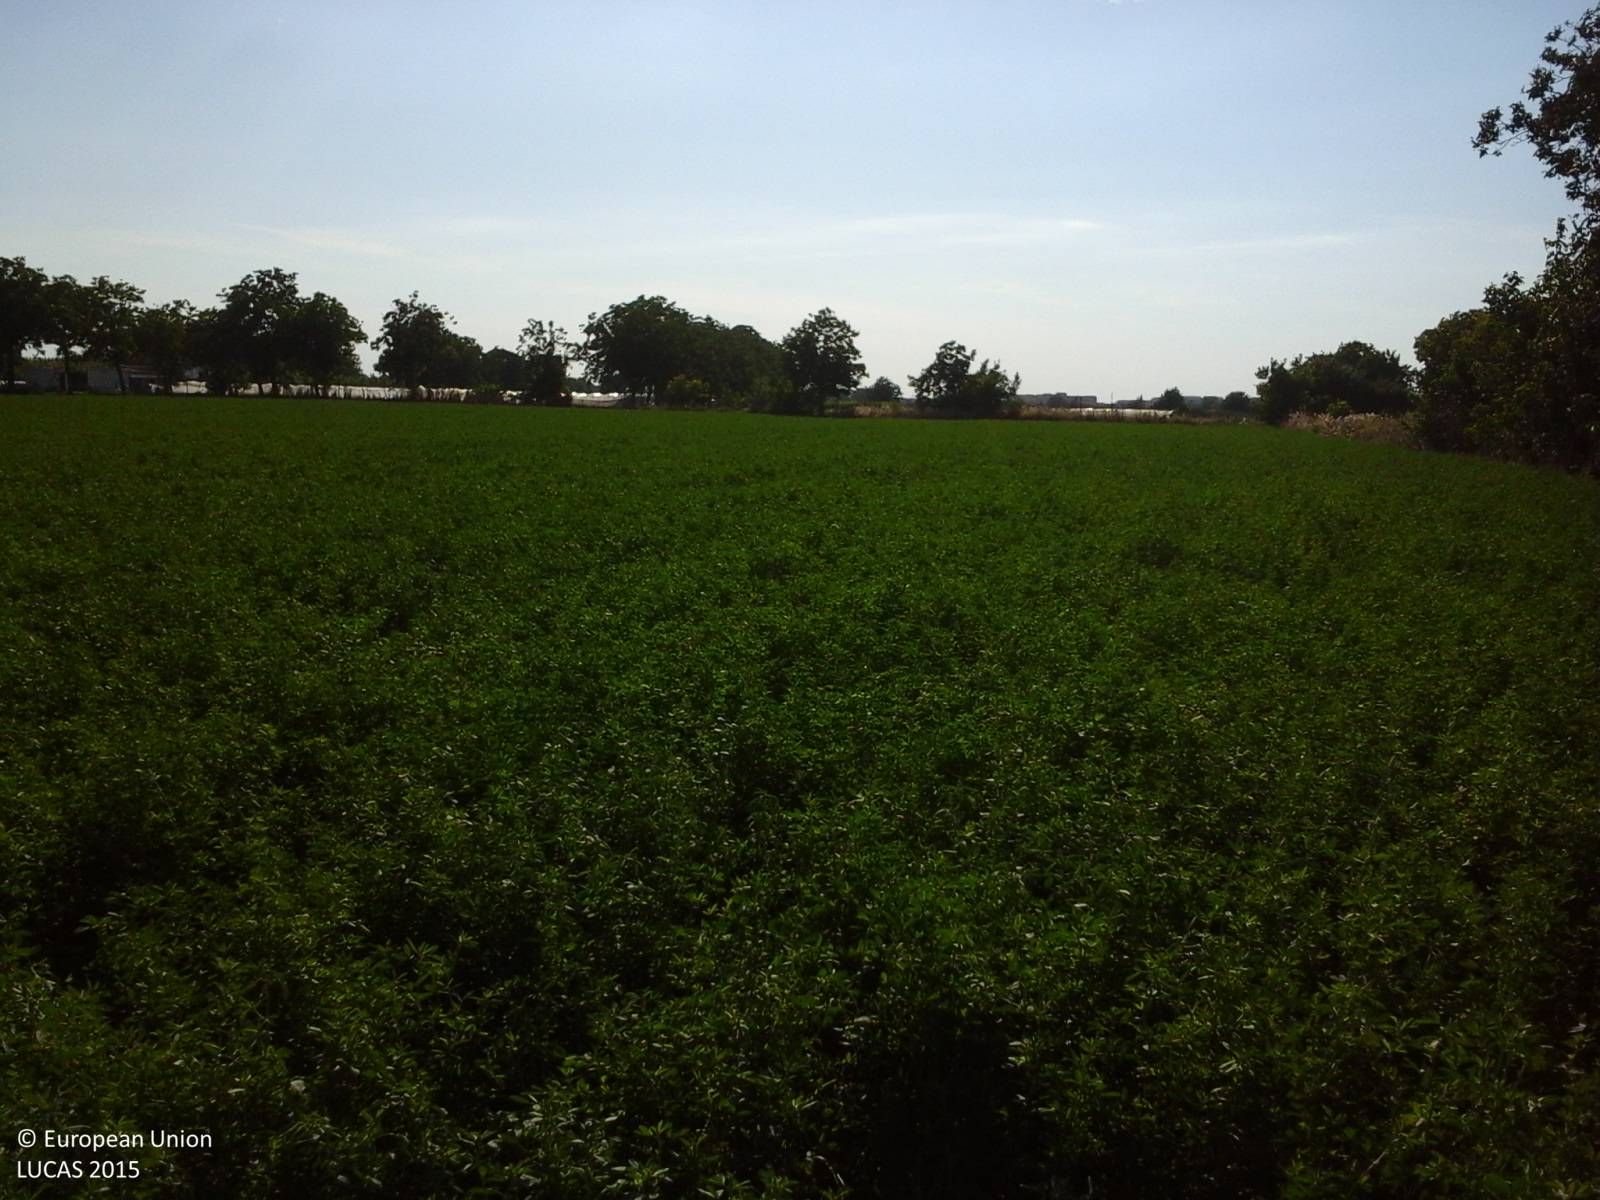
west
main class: Cropland
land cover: Lucerne
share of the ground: > 75 %
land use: Agriculture (excluding fallow land and kitchen gardens)
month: June
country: IT
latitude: 40.9895
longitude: 14.2737
